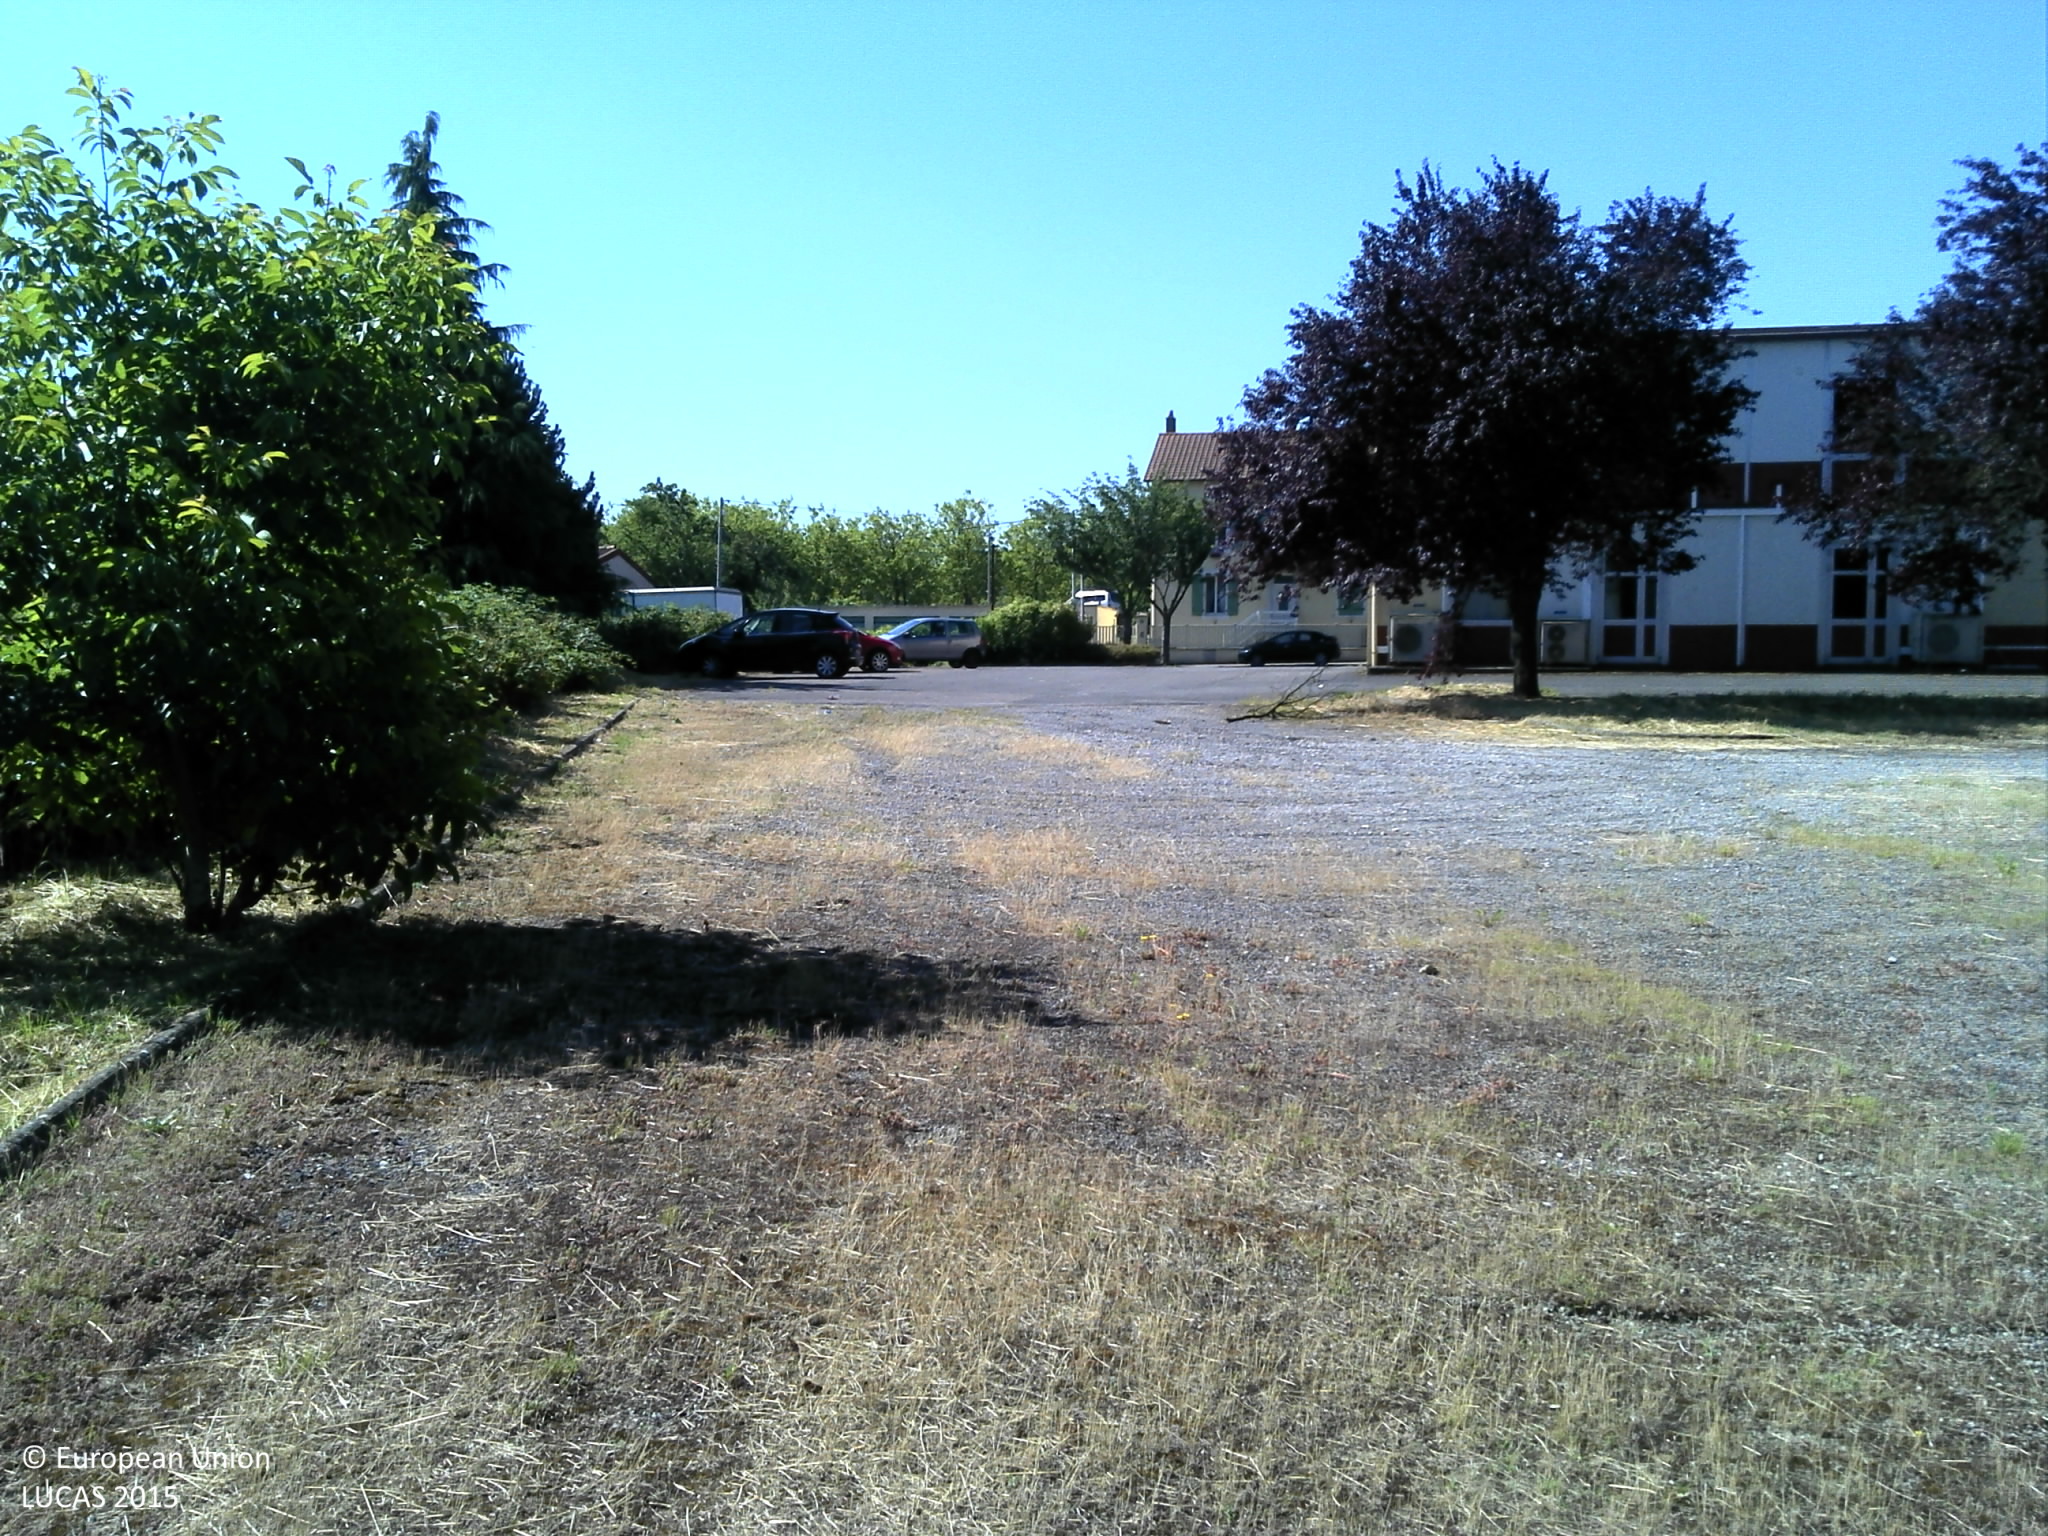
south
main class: Grassland
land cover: Spontaneously vegetated surfaces
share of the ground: 50 - 75 %
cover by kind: unconsolidated bare surface 50 %, herbaceous plants 30 %, lichens and mosses 20 %
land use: Community services
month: June
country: FR
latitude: 49.3265
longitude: 6.1332
